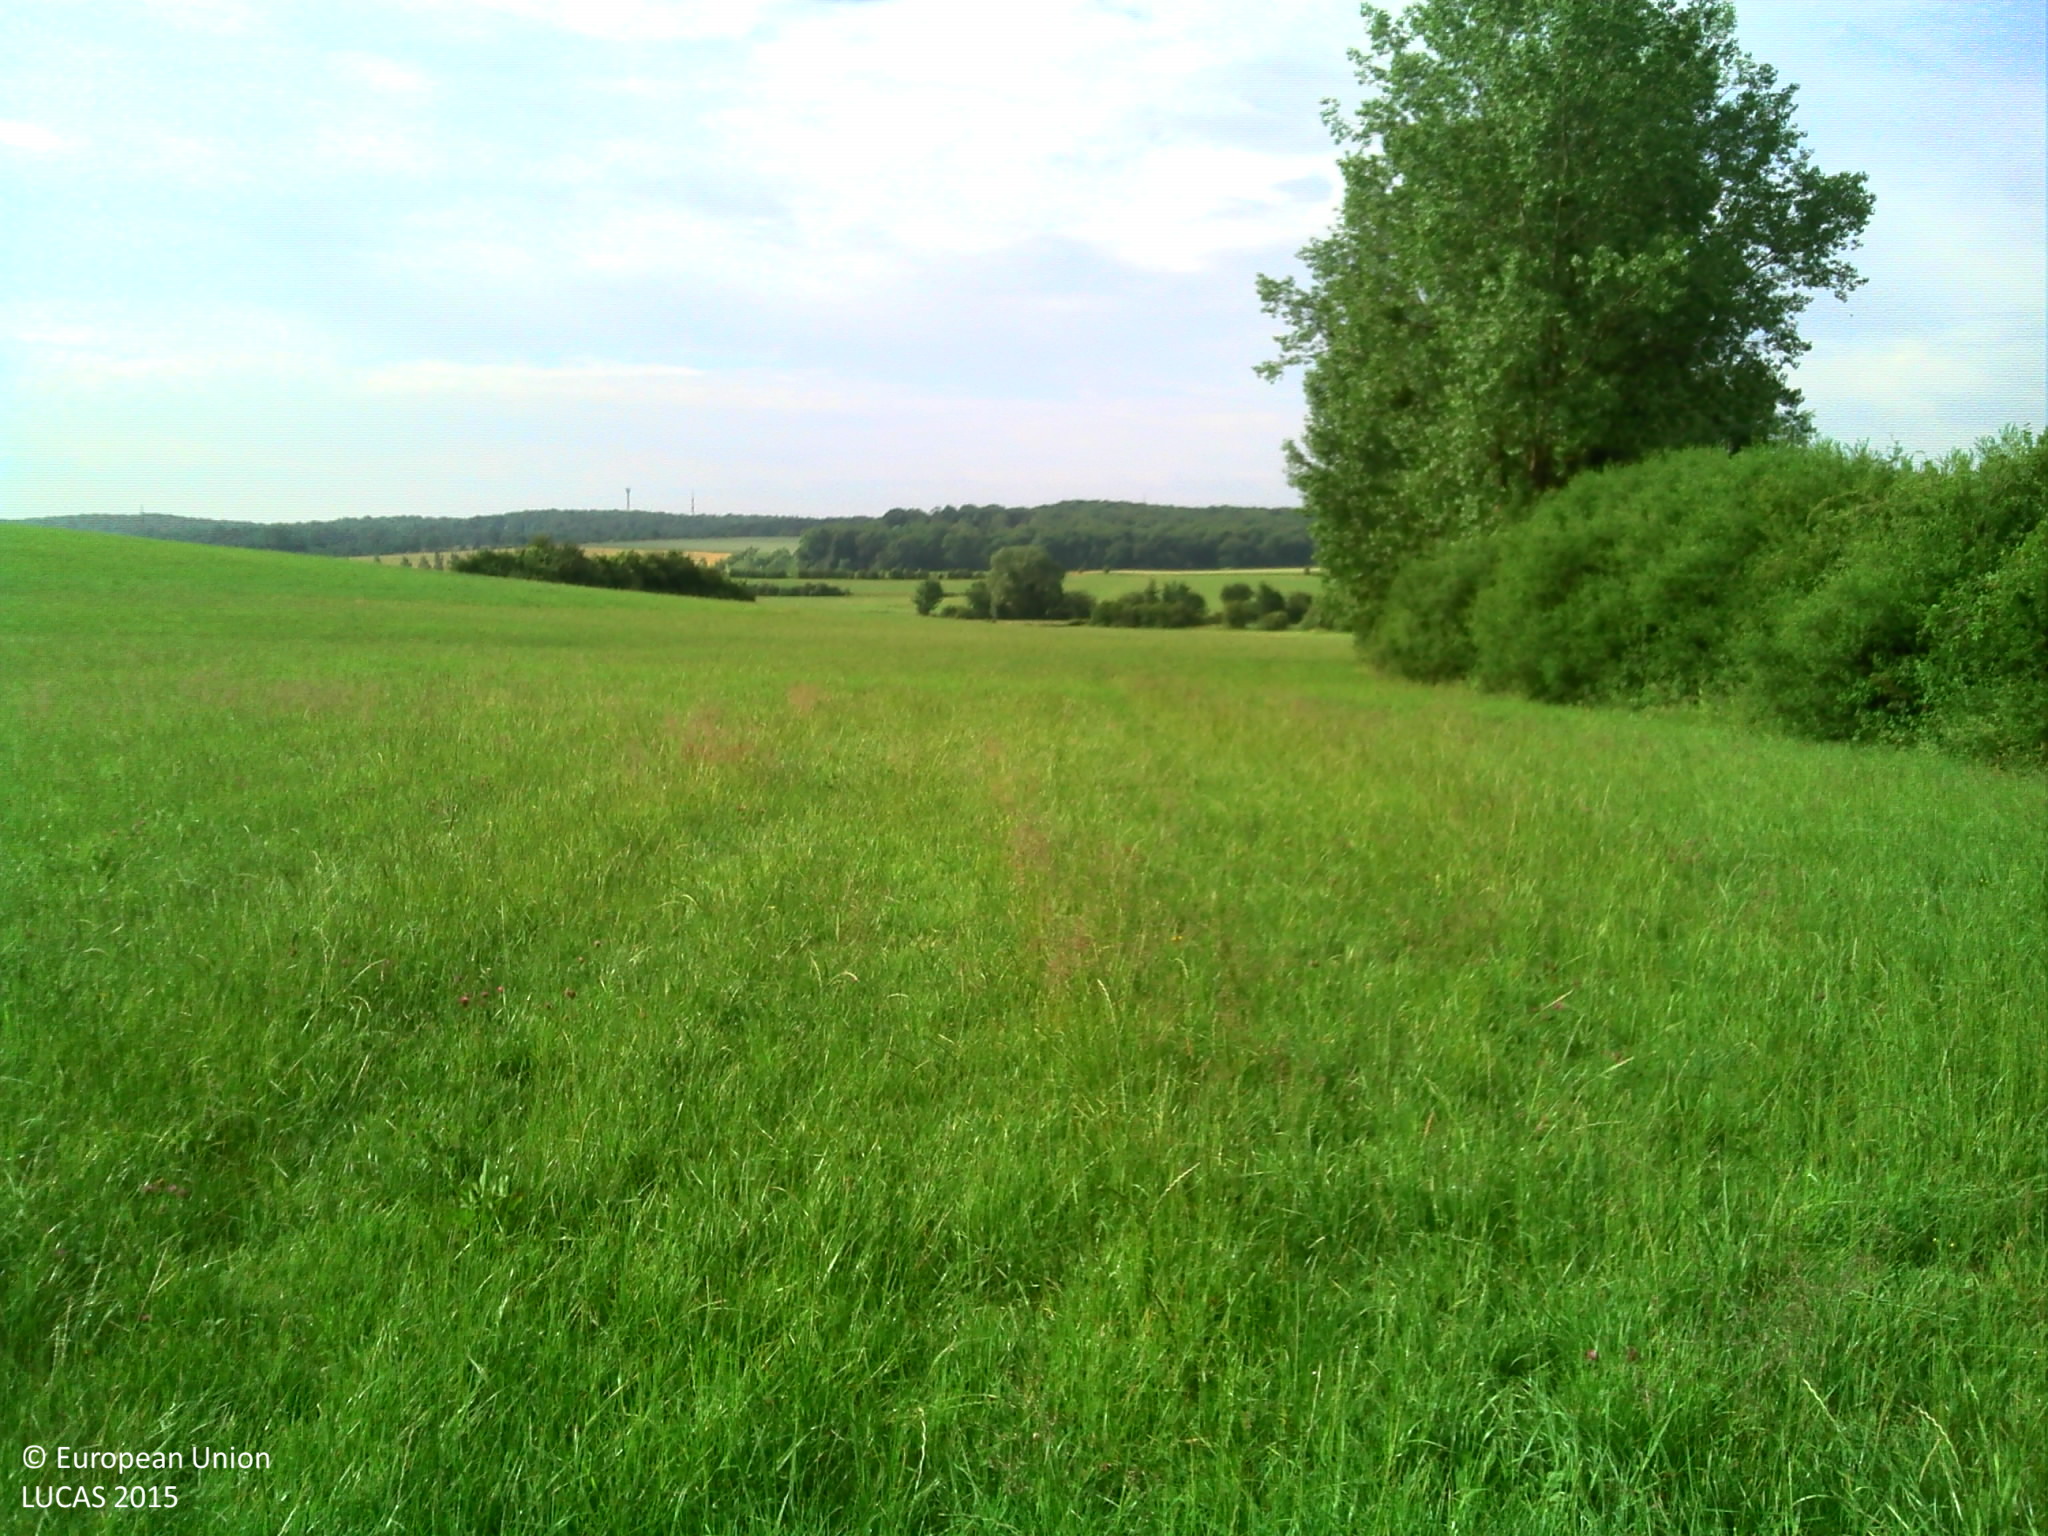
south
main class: Grassland
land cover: Grassland without tree/shrub cover
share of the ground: > 75 %
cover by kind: herbaceous plants 100 %
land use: Agriculture (excluding fallow land and kitchen gardens)
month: June
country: LU
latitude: 49.7487
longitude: 6.3773
